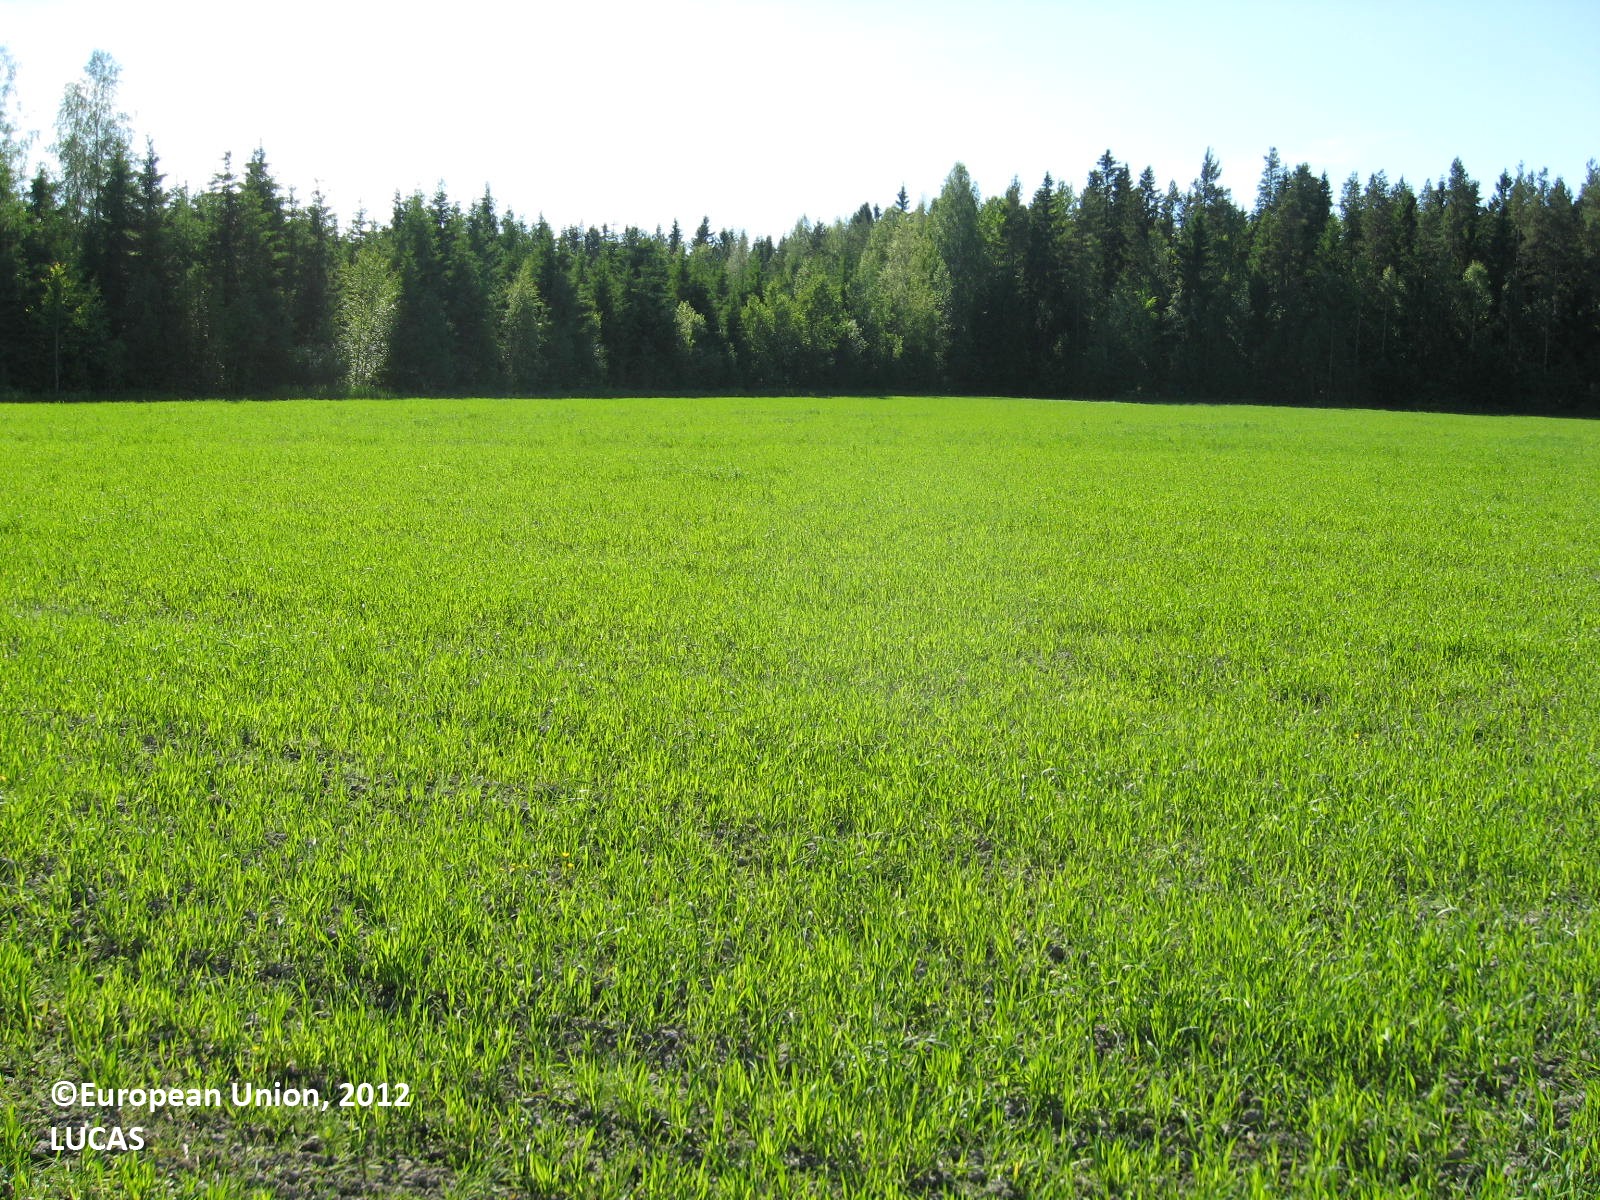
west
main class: Cropland
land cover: Rye
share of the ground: > 75 %
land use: Agriculture (excluding fallow land and kitchen gardens)
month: June
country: FI
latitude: 62.7431
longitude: 21.6493
